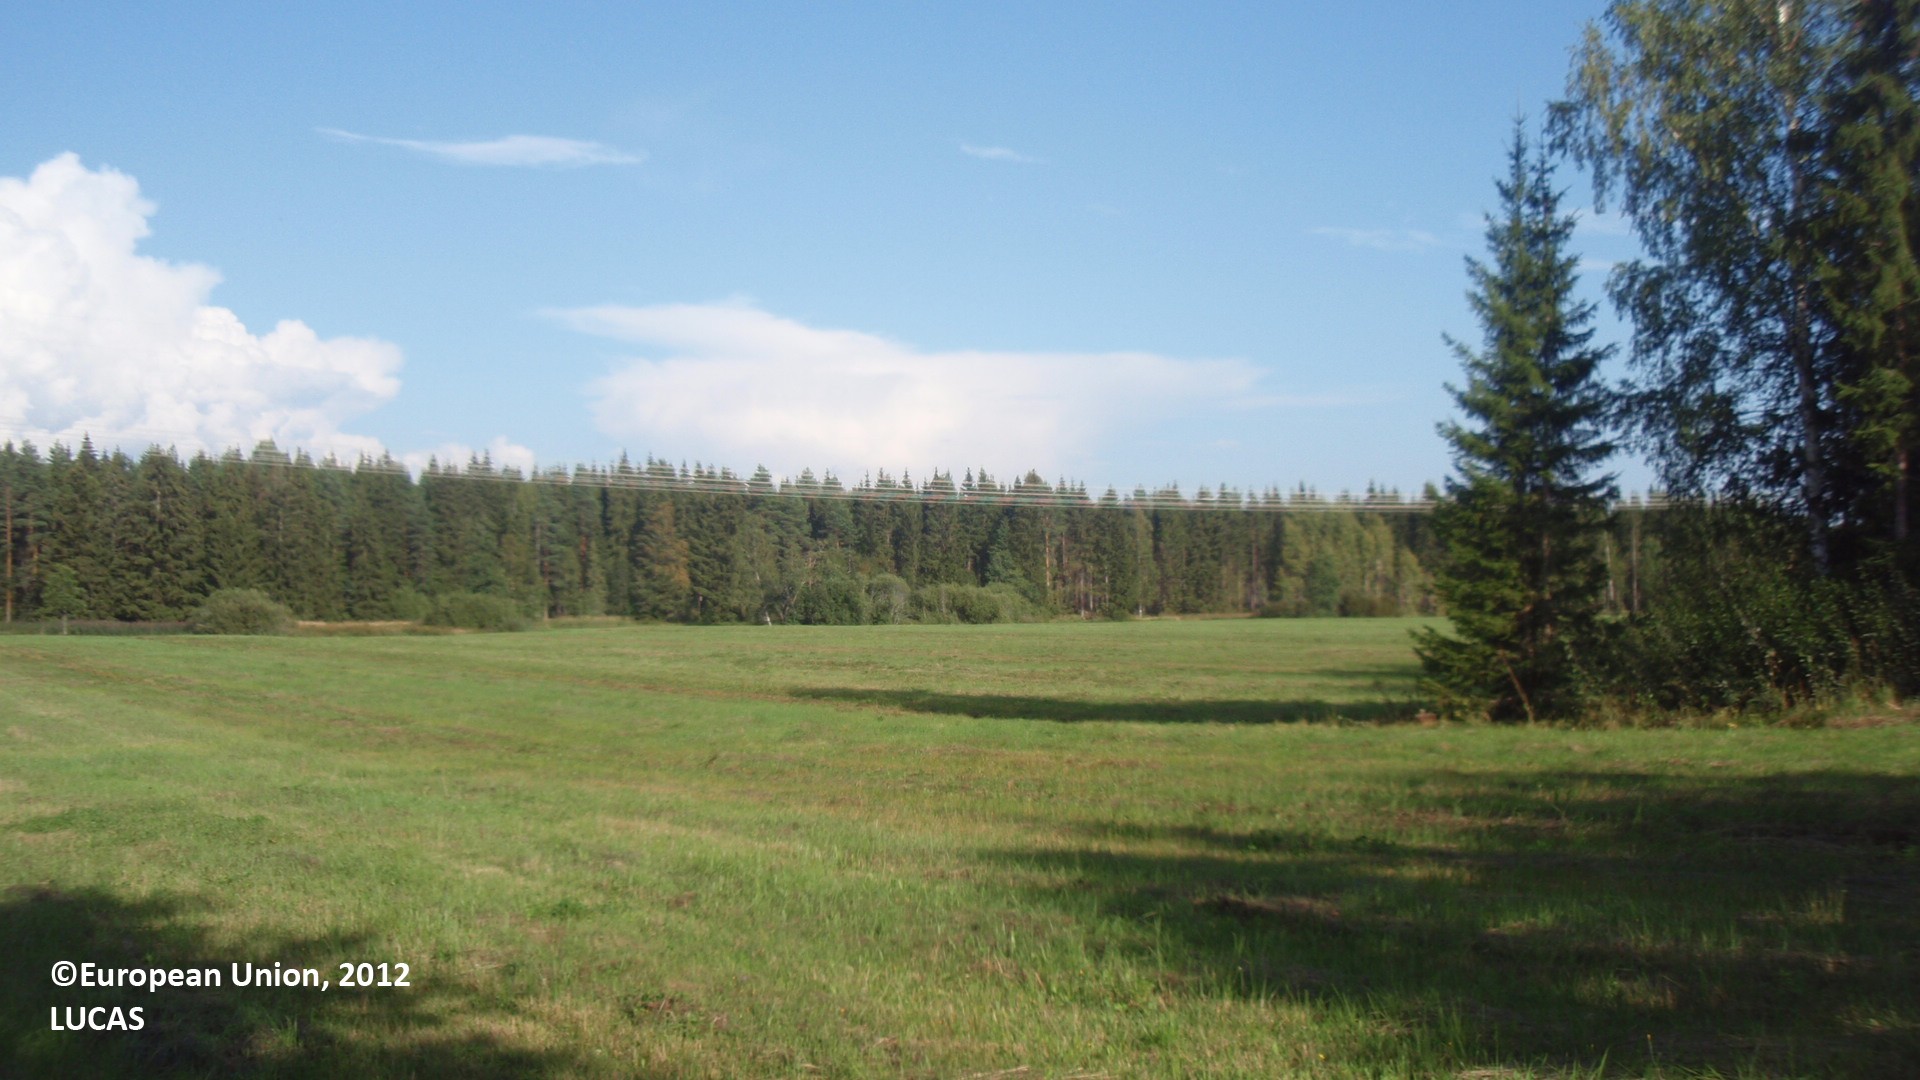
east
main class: Cropland
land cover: Mixed cereals for fodder
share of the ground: > 75 %
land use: Agriculture (excluding fallow land and kitchen gardens)
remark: Harvested field
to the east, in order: Mixed cereals for fodder
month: August
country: FI
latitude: 60.7756
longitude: 26.5899
